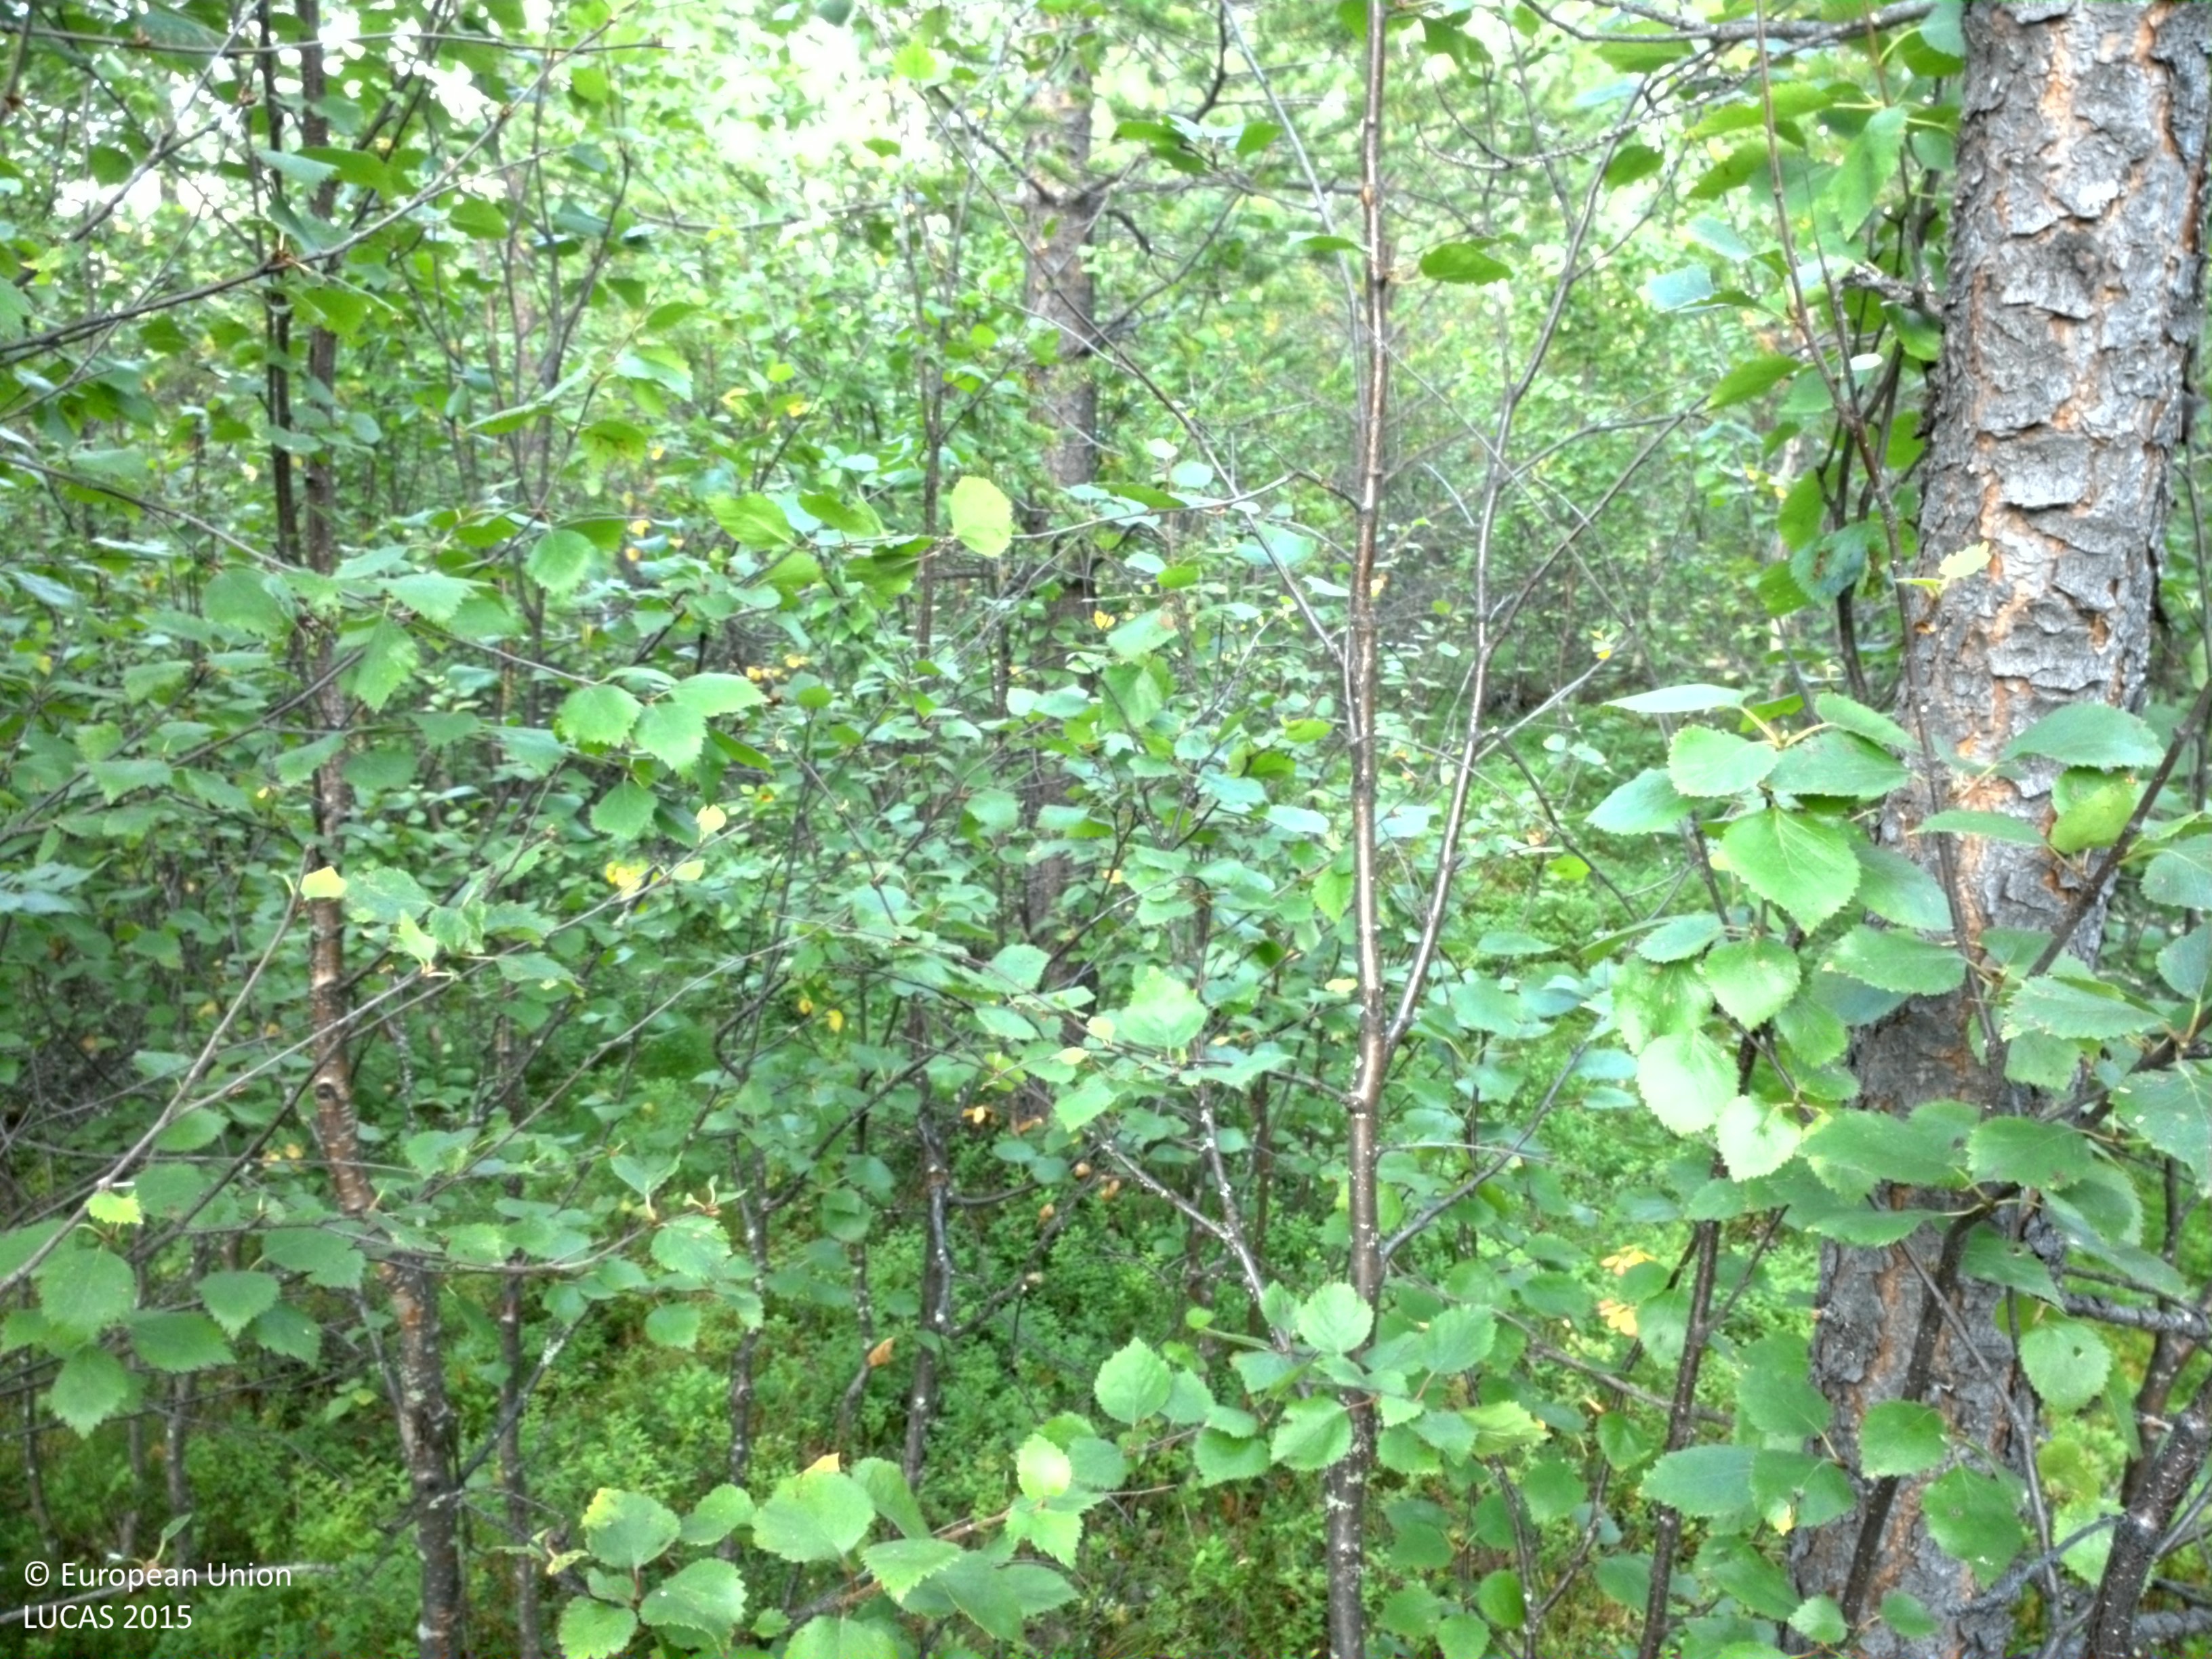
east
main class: Woodland
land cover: Pine dominated mixed woodland
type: boreal forest
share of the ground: 50 - 75 %
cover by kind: broadleaved forest trees 50 %, shrubs 30 %, coniferous forest trees 20 %
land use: Forestry
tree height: > 5 m
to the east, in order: Pine dominated mixed woodland; Spruce dominated mixed woodland
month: August
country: SE
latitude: 66.6684
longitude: 19.1139
